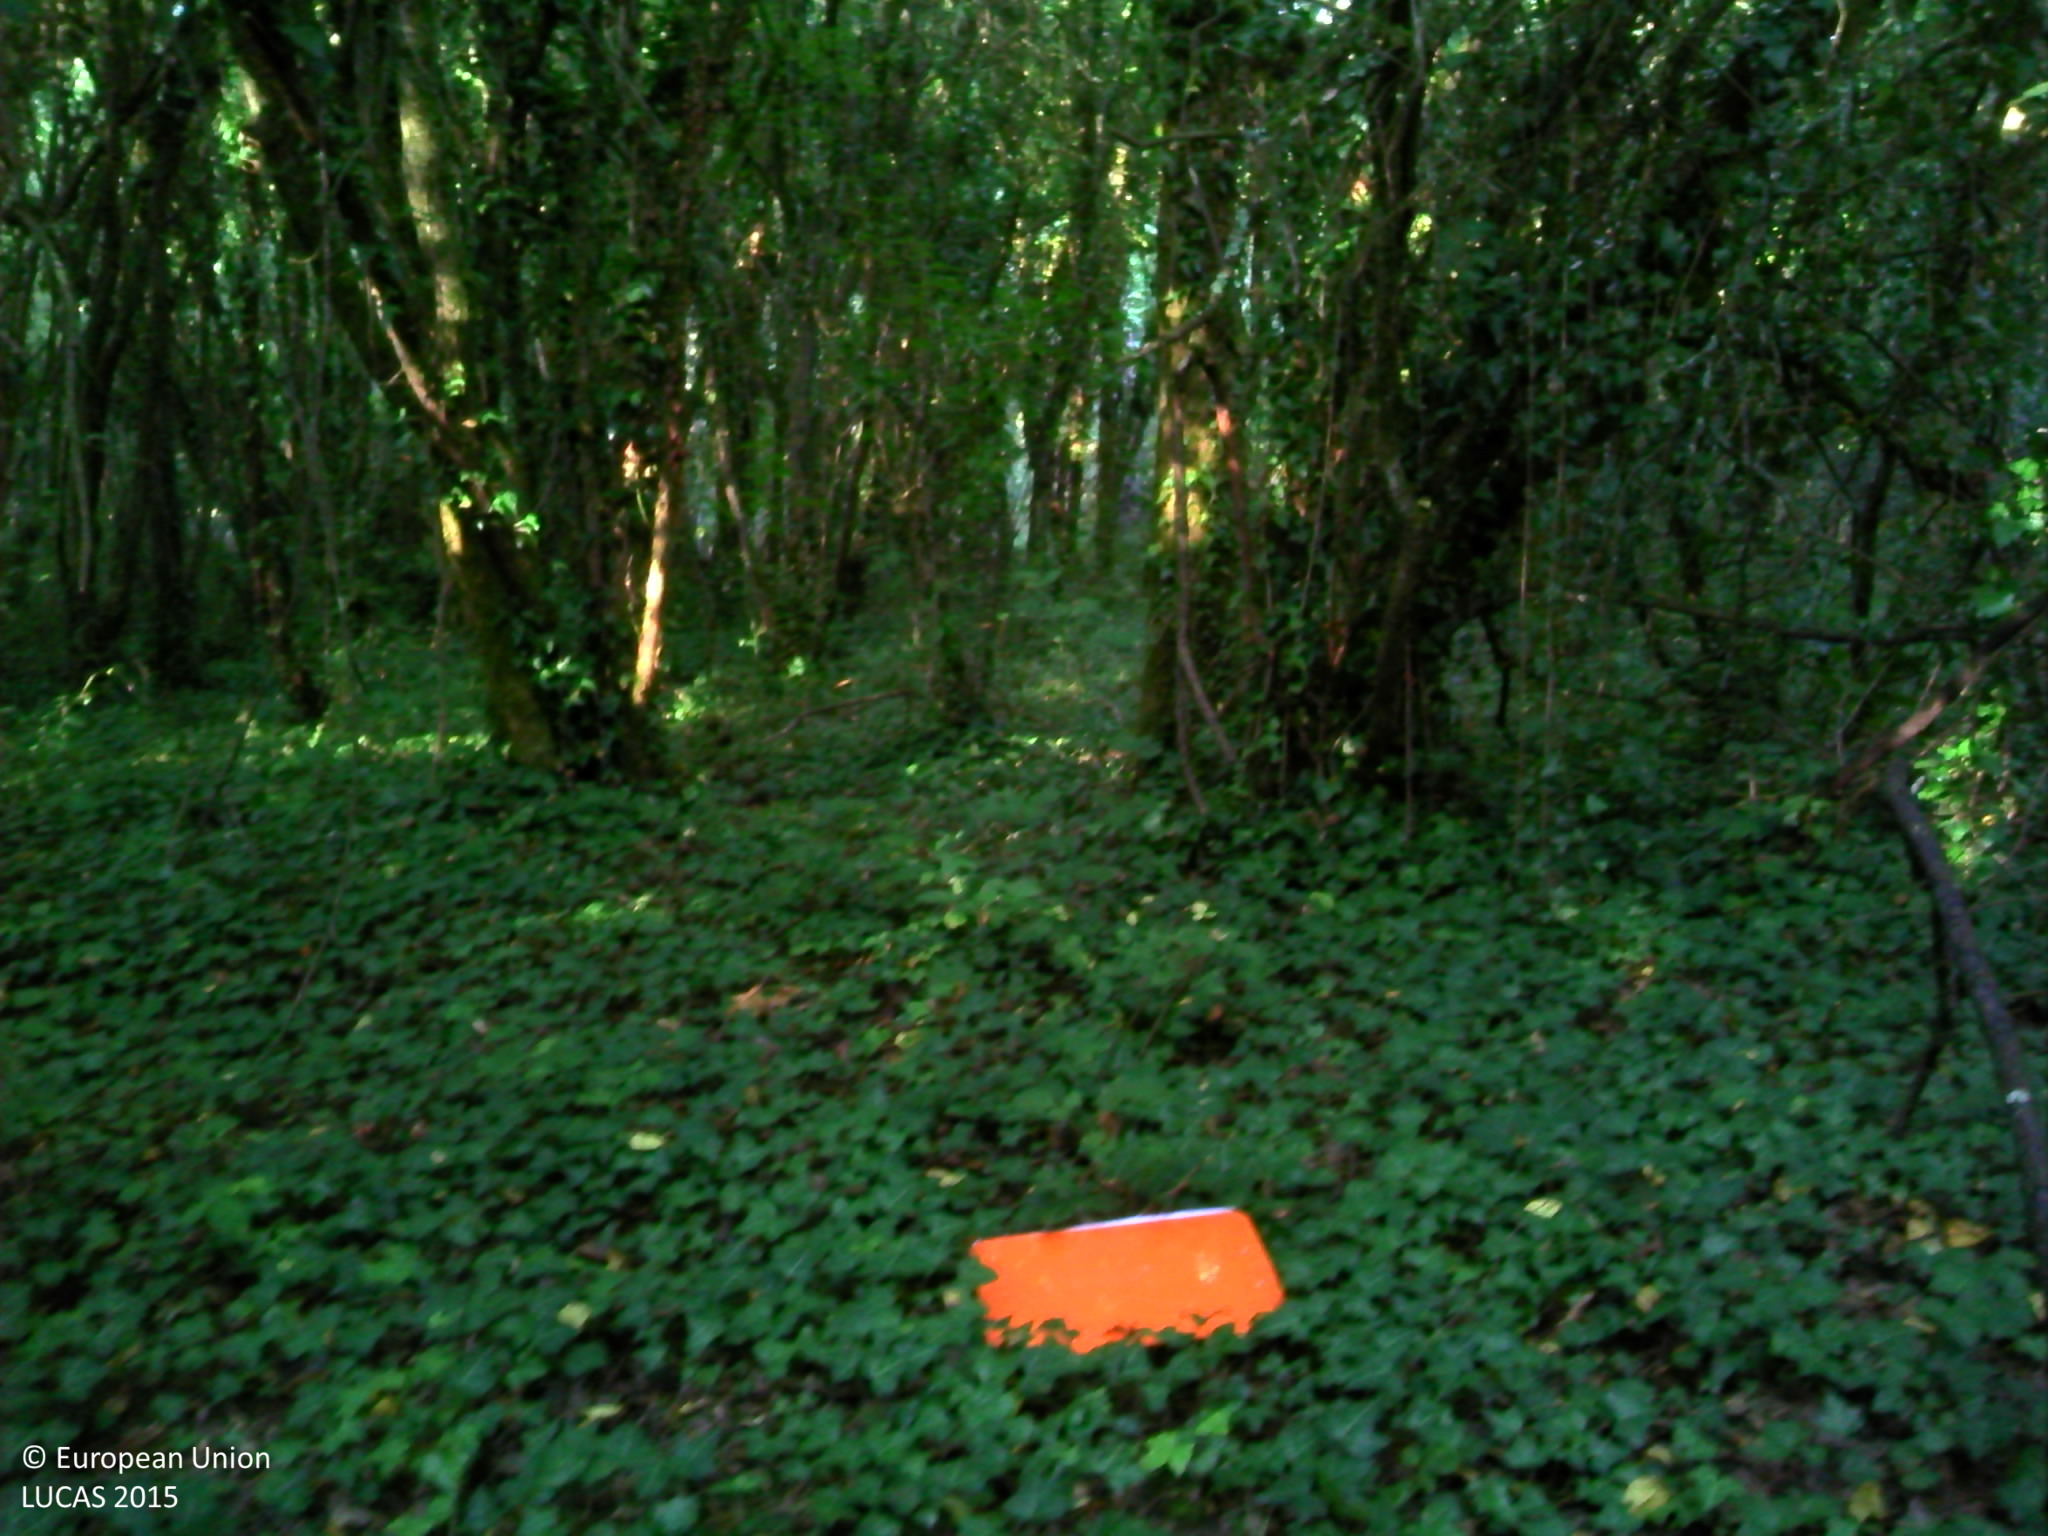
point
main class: Woodland
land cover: Broadleaved woodland
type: mesophytic deciduous forest
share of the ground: > 75 %
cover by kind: broadleaved forest trees 95 %, herbaceous plants 5 %
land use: Semi-natural and natural areas not in use
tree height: > 5 m
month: August
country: FR
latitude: 47.3584
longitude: -1.8970
